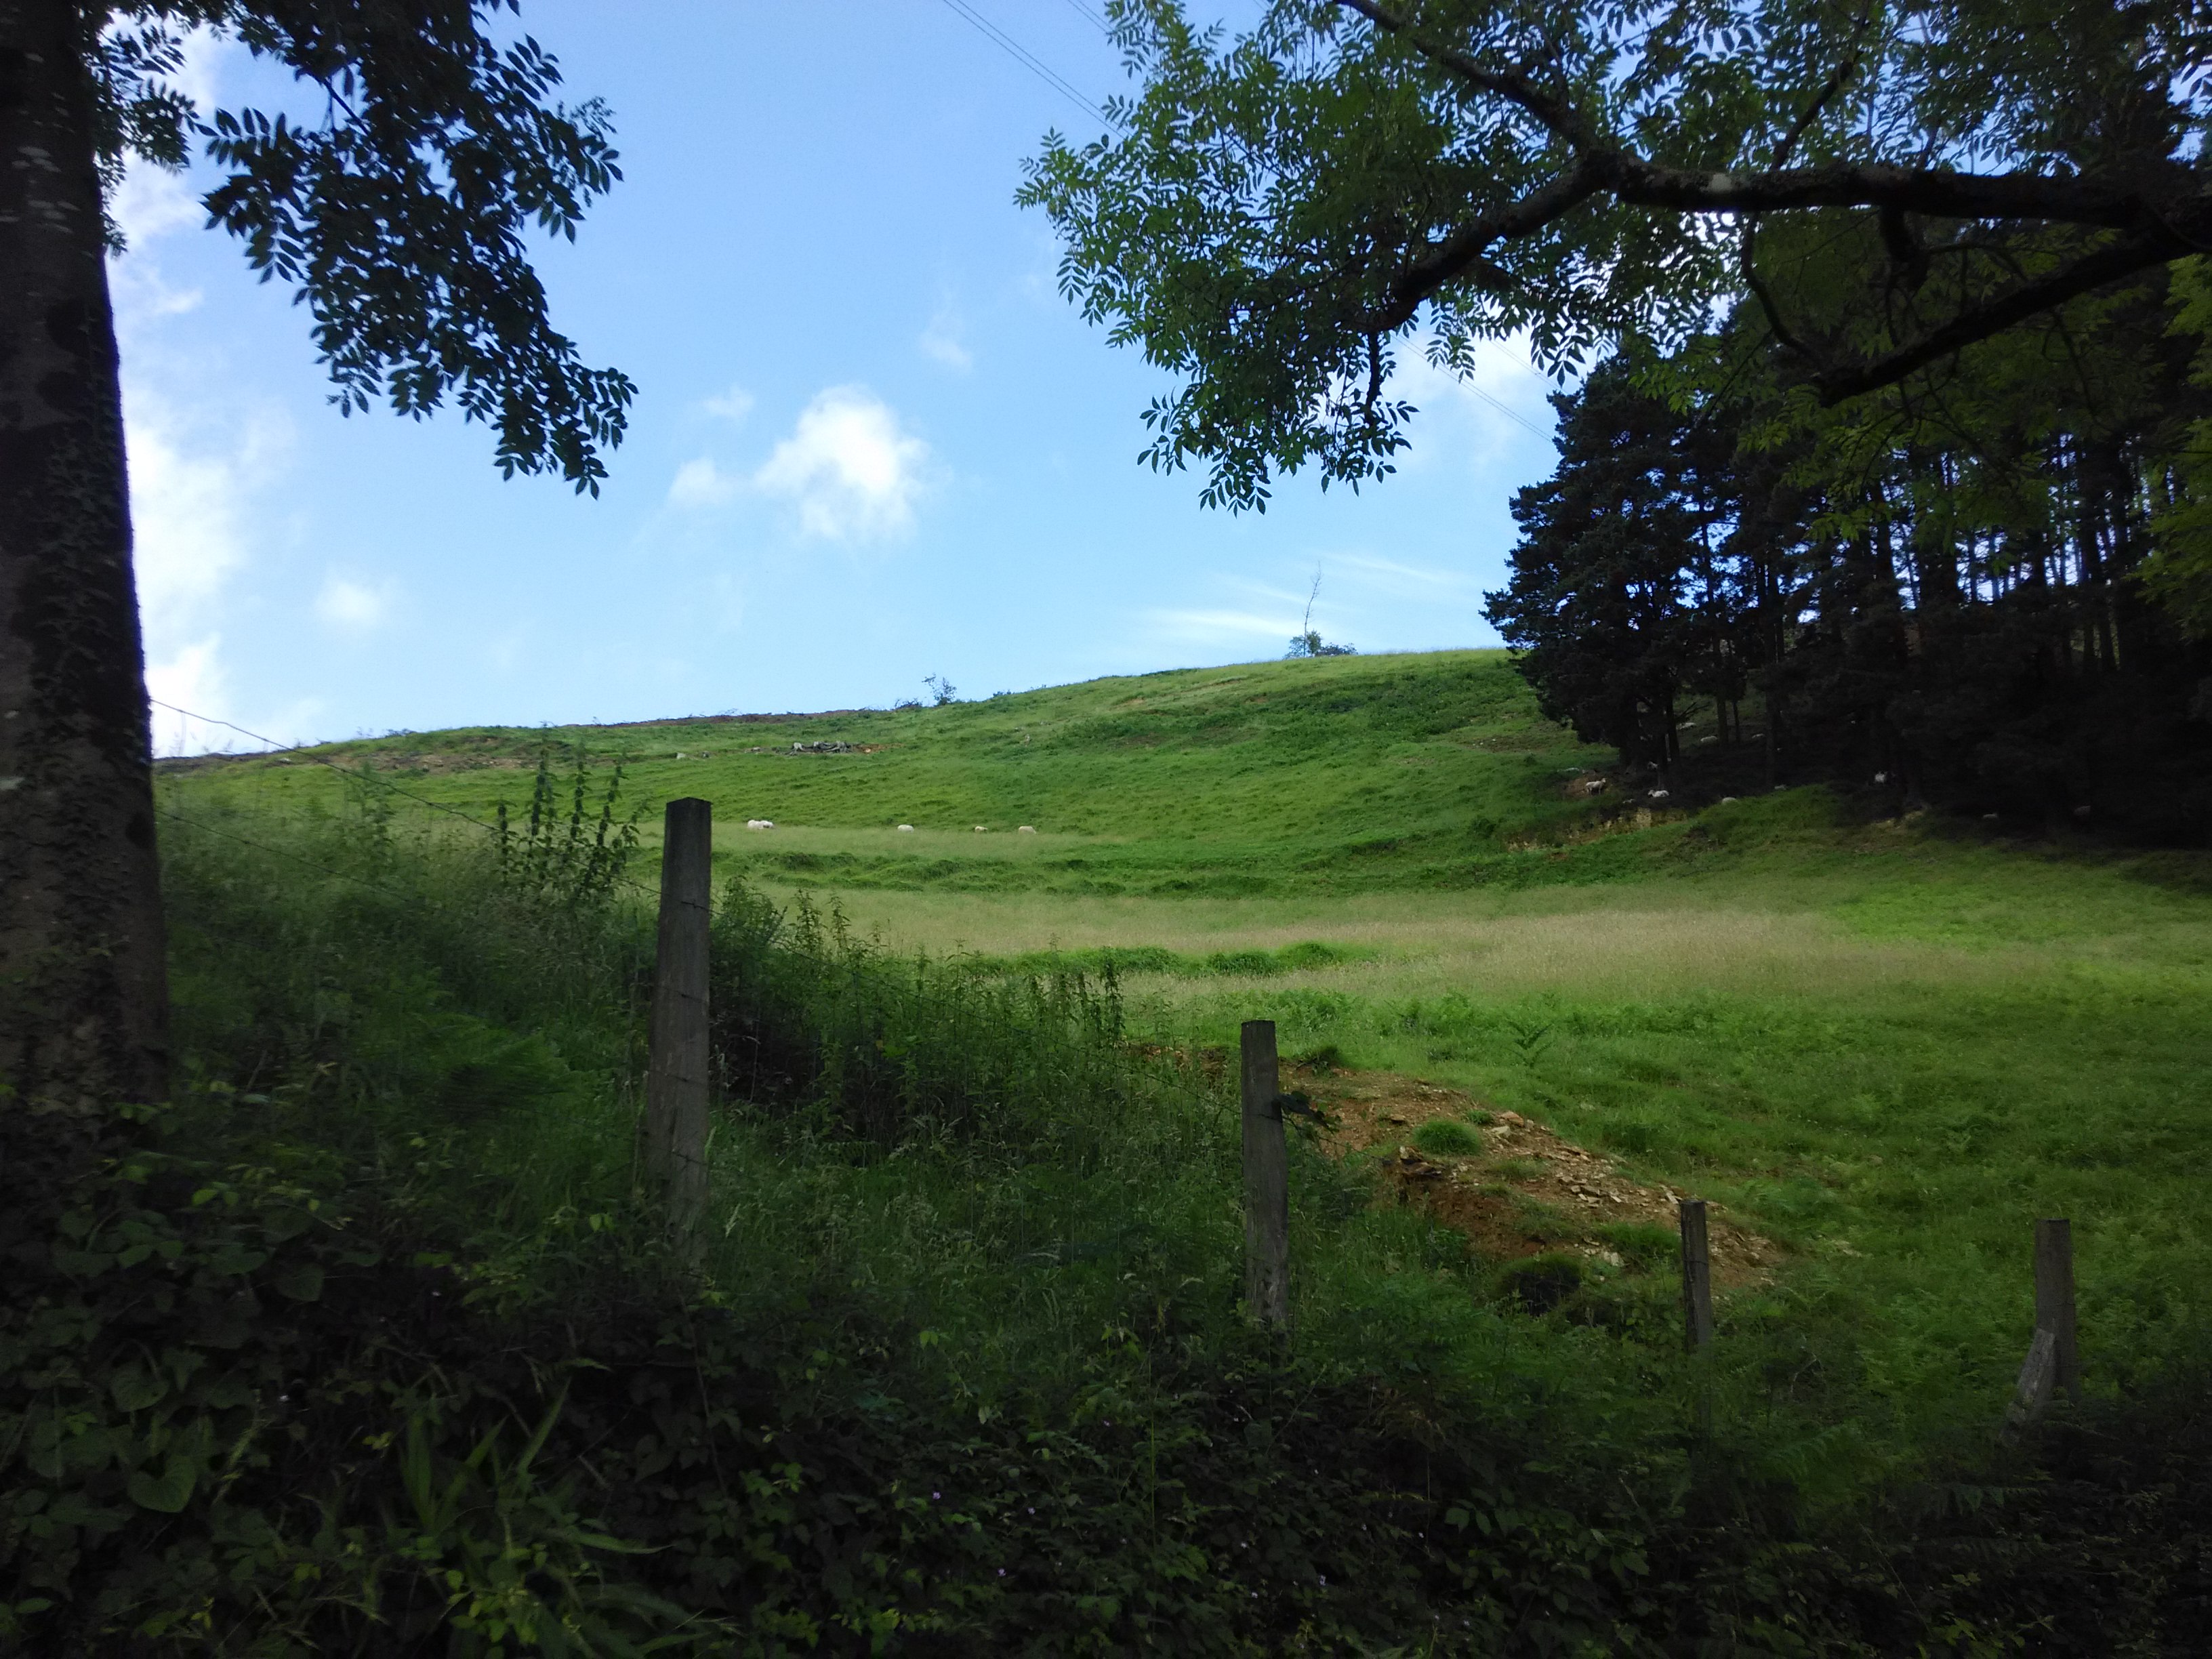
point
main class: Grassland
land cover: Grassland without tree/shrub cover
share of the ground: > 75 %
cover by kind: herbaceous plants 100 %
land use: Agriculture (excluding fallow land and kitchen gardens)
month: June
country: ES
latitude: 43.2208
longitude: -2.2496
